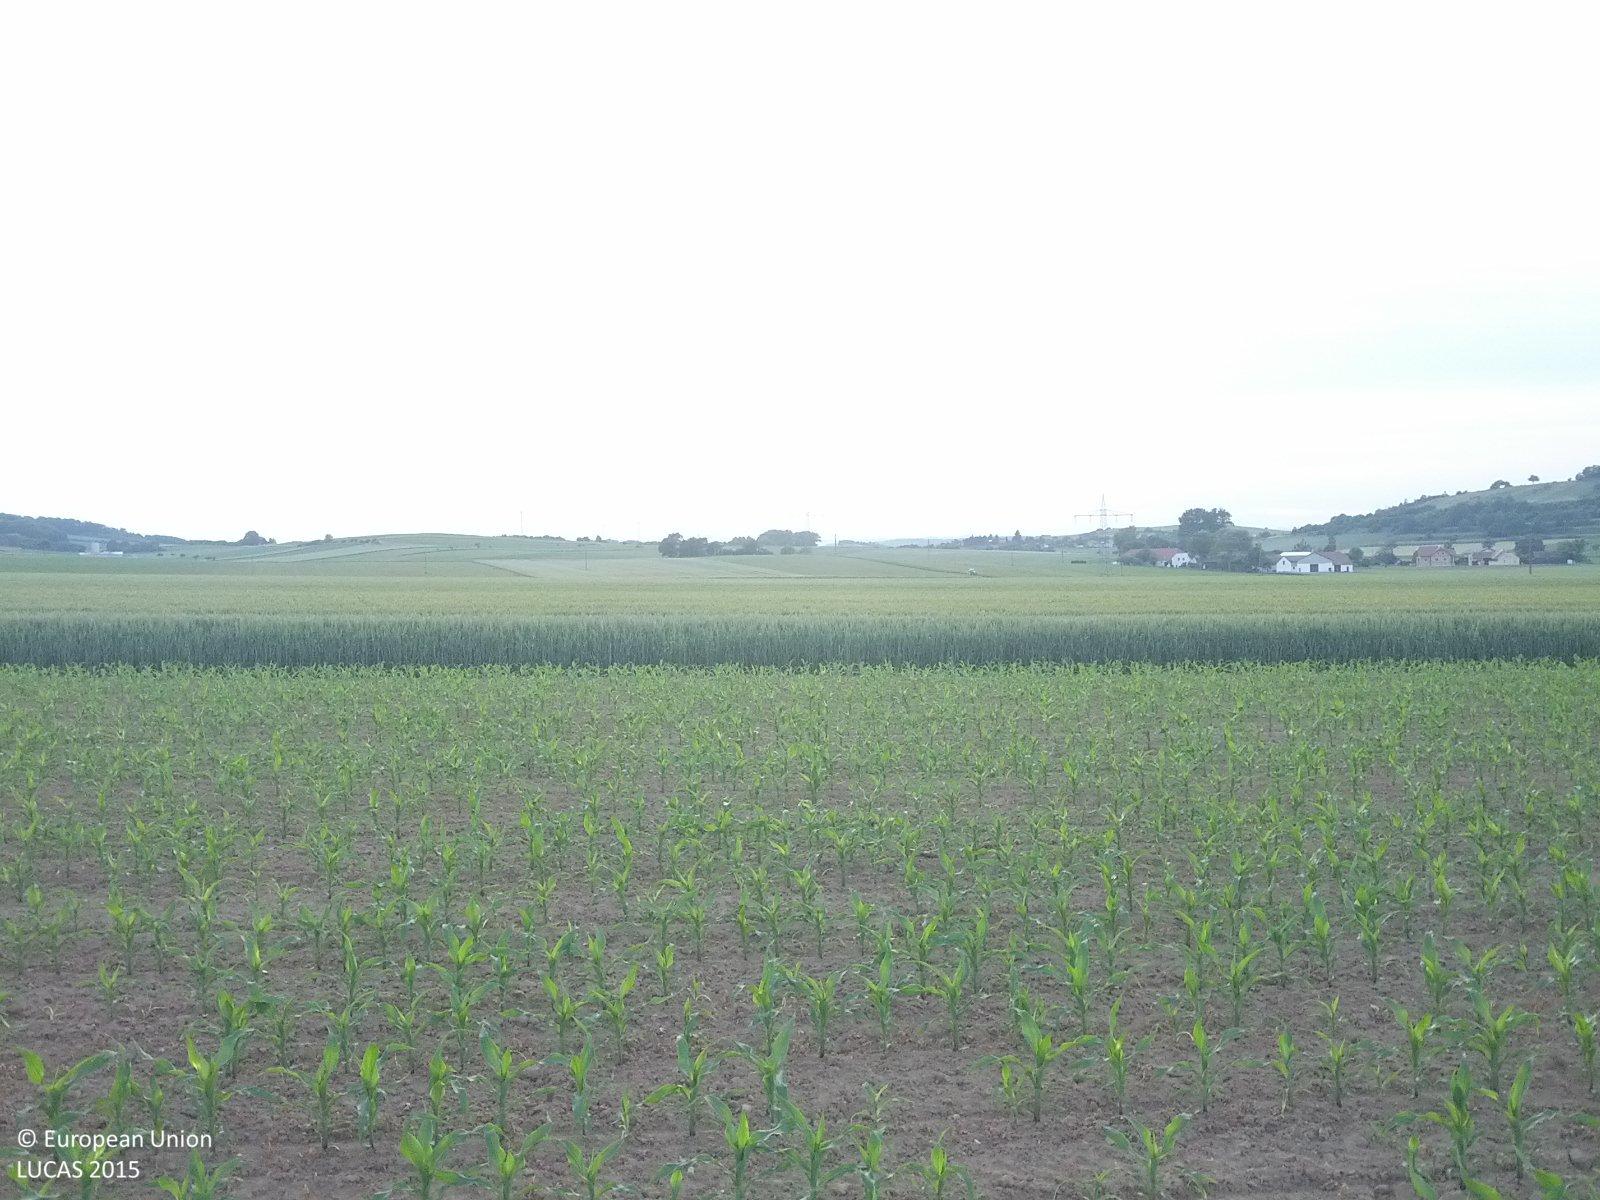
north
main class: Cropland
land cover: Maize
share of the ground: < 10 %
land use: Agriculture (excluding fallow land and kitchen gardens)
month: May
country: AT
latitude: 48.2466
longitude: 15.8884
